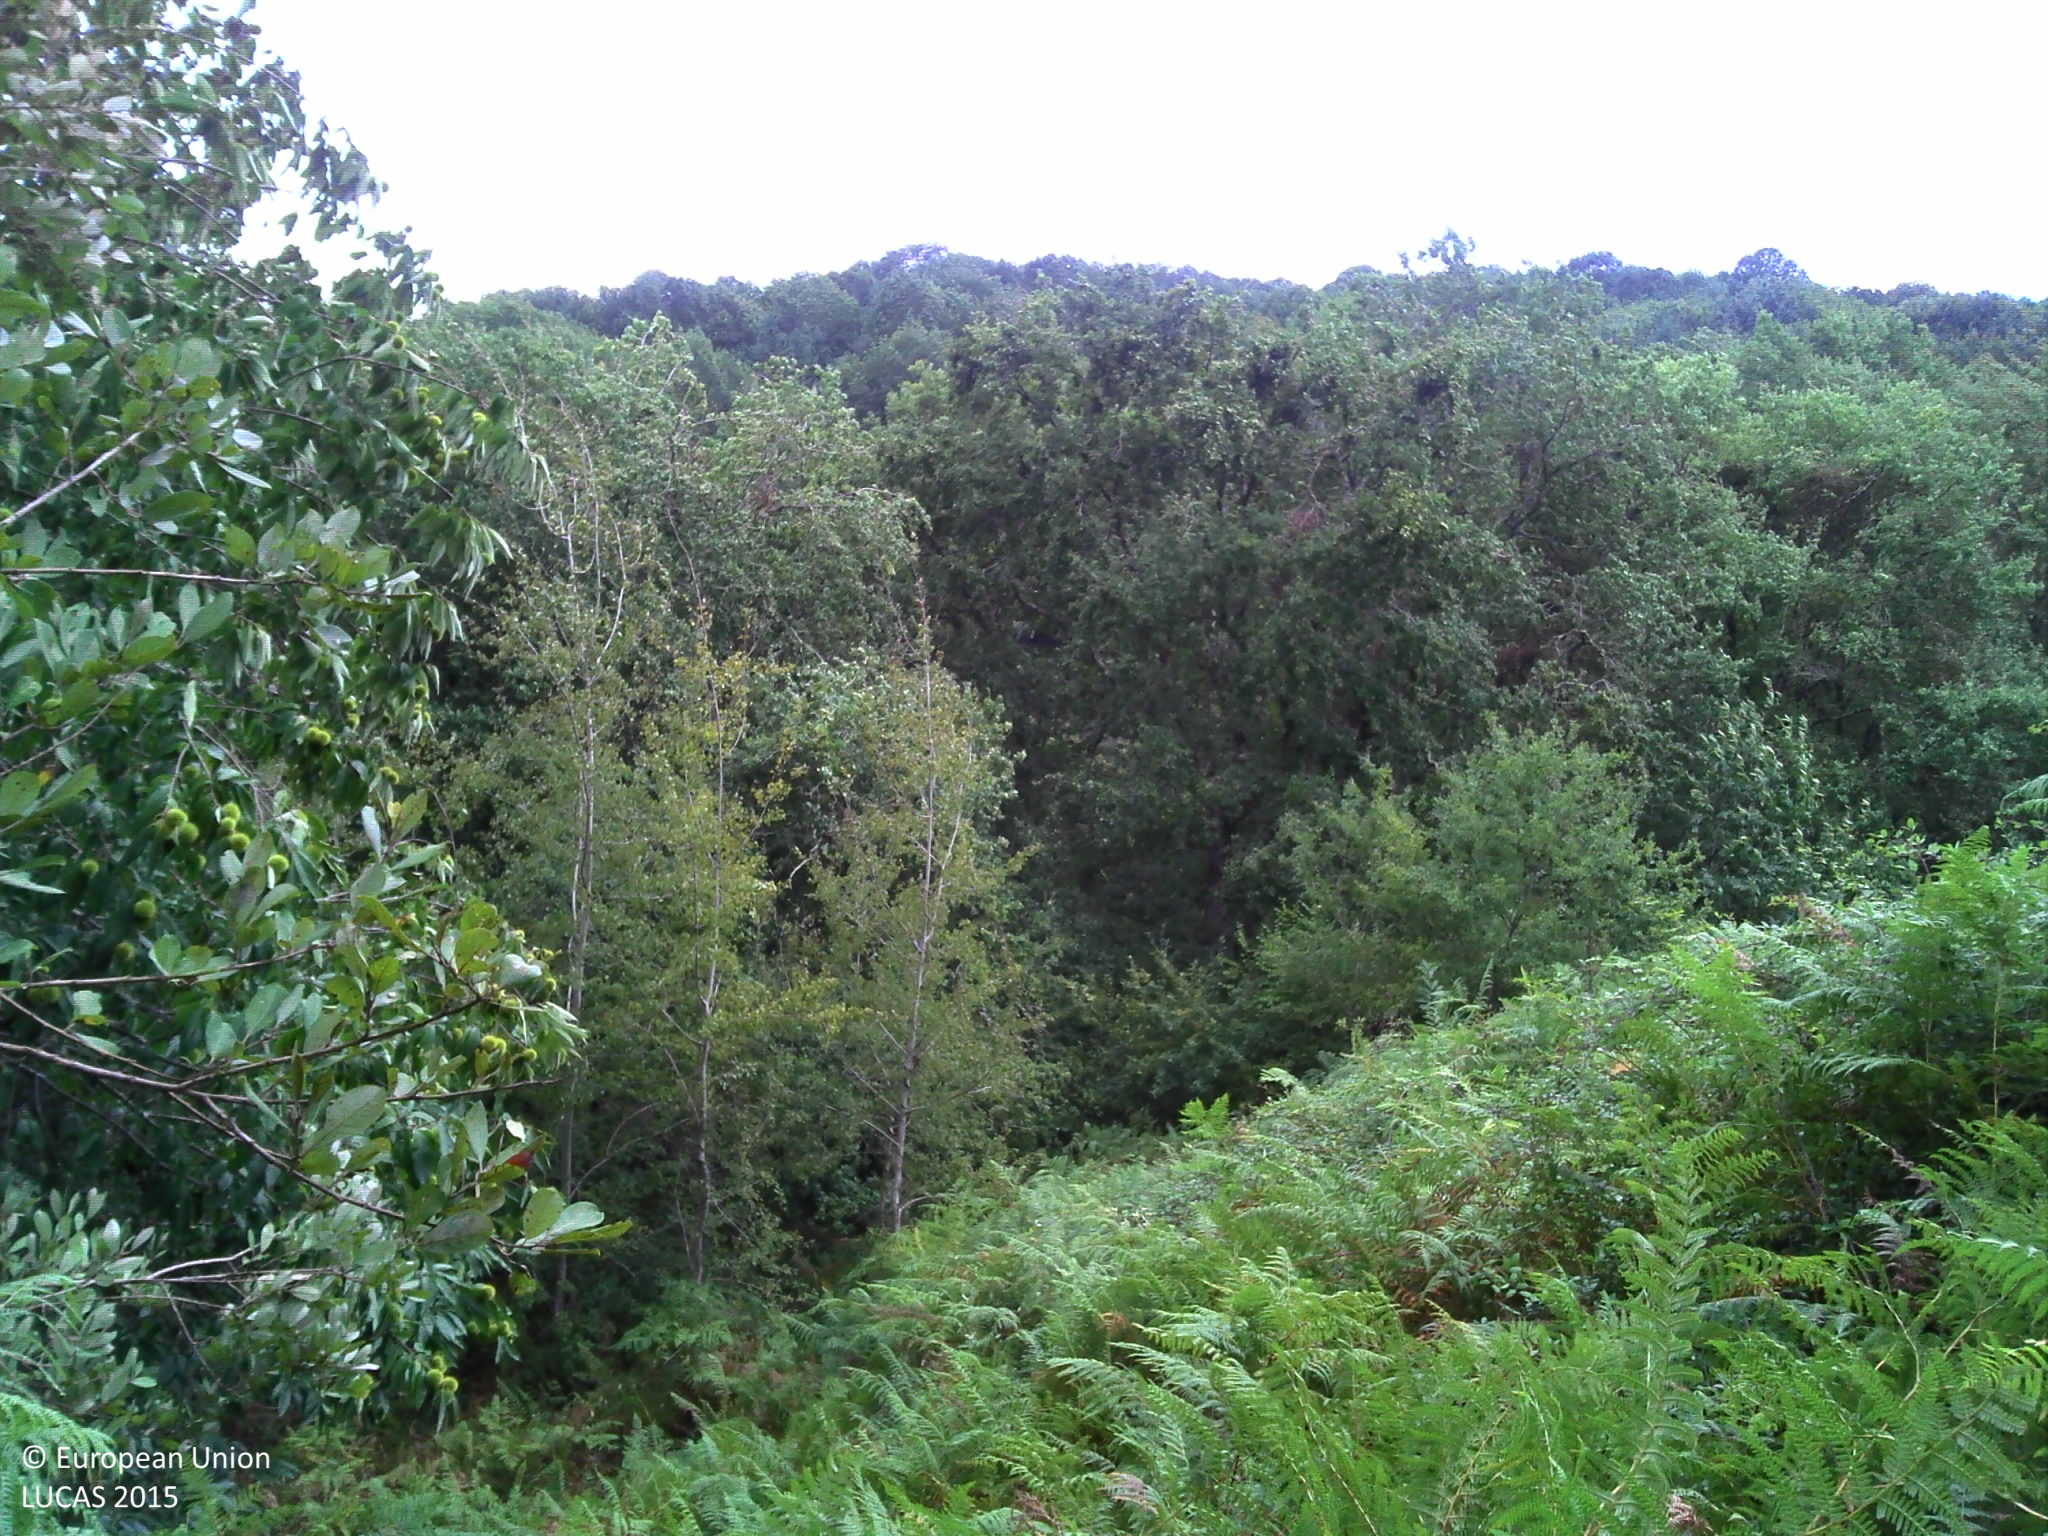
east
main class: Shrubland
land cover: Shrubland without tree cover
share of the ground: > 75 %
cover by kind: shrubs 50 %, herbaceous plants 50 %
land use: Abandoned areas
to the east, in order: Shrubland without tree cover; Broadleaved woodland; Pine dominated coniferous woodland; Tracks; Broadleaved woodland; Rivers and streams; Broadleaved woodland; Pine dominated coniferous woodland; Pine dominated mixed woodland
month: September
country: FR
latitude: 43.3381
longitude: -0.7288
